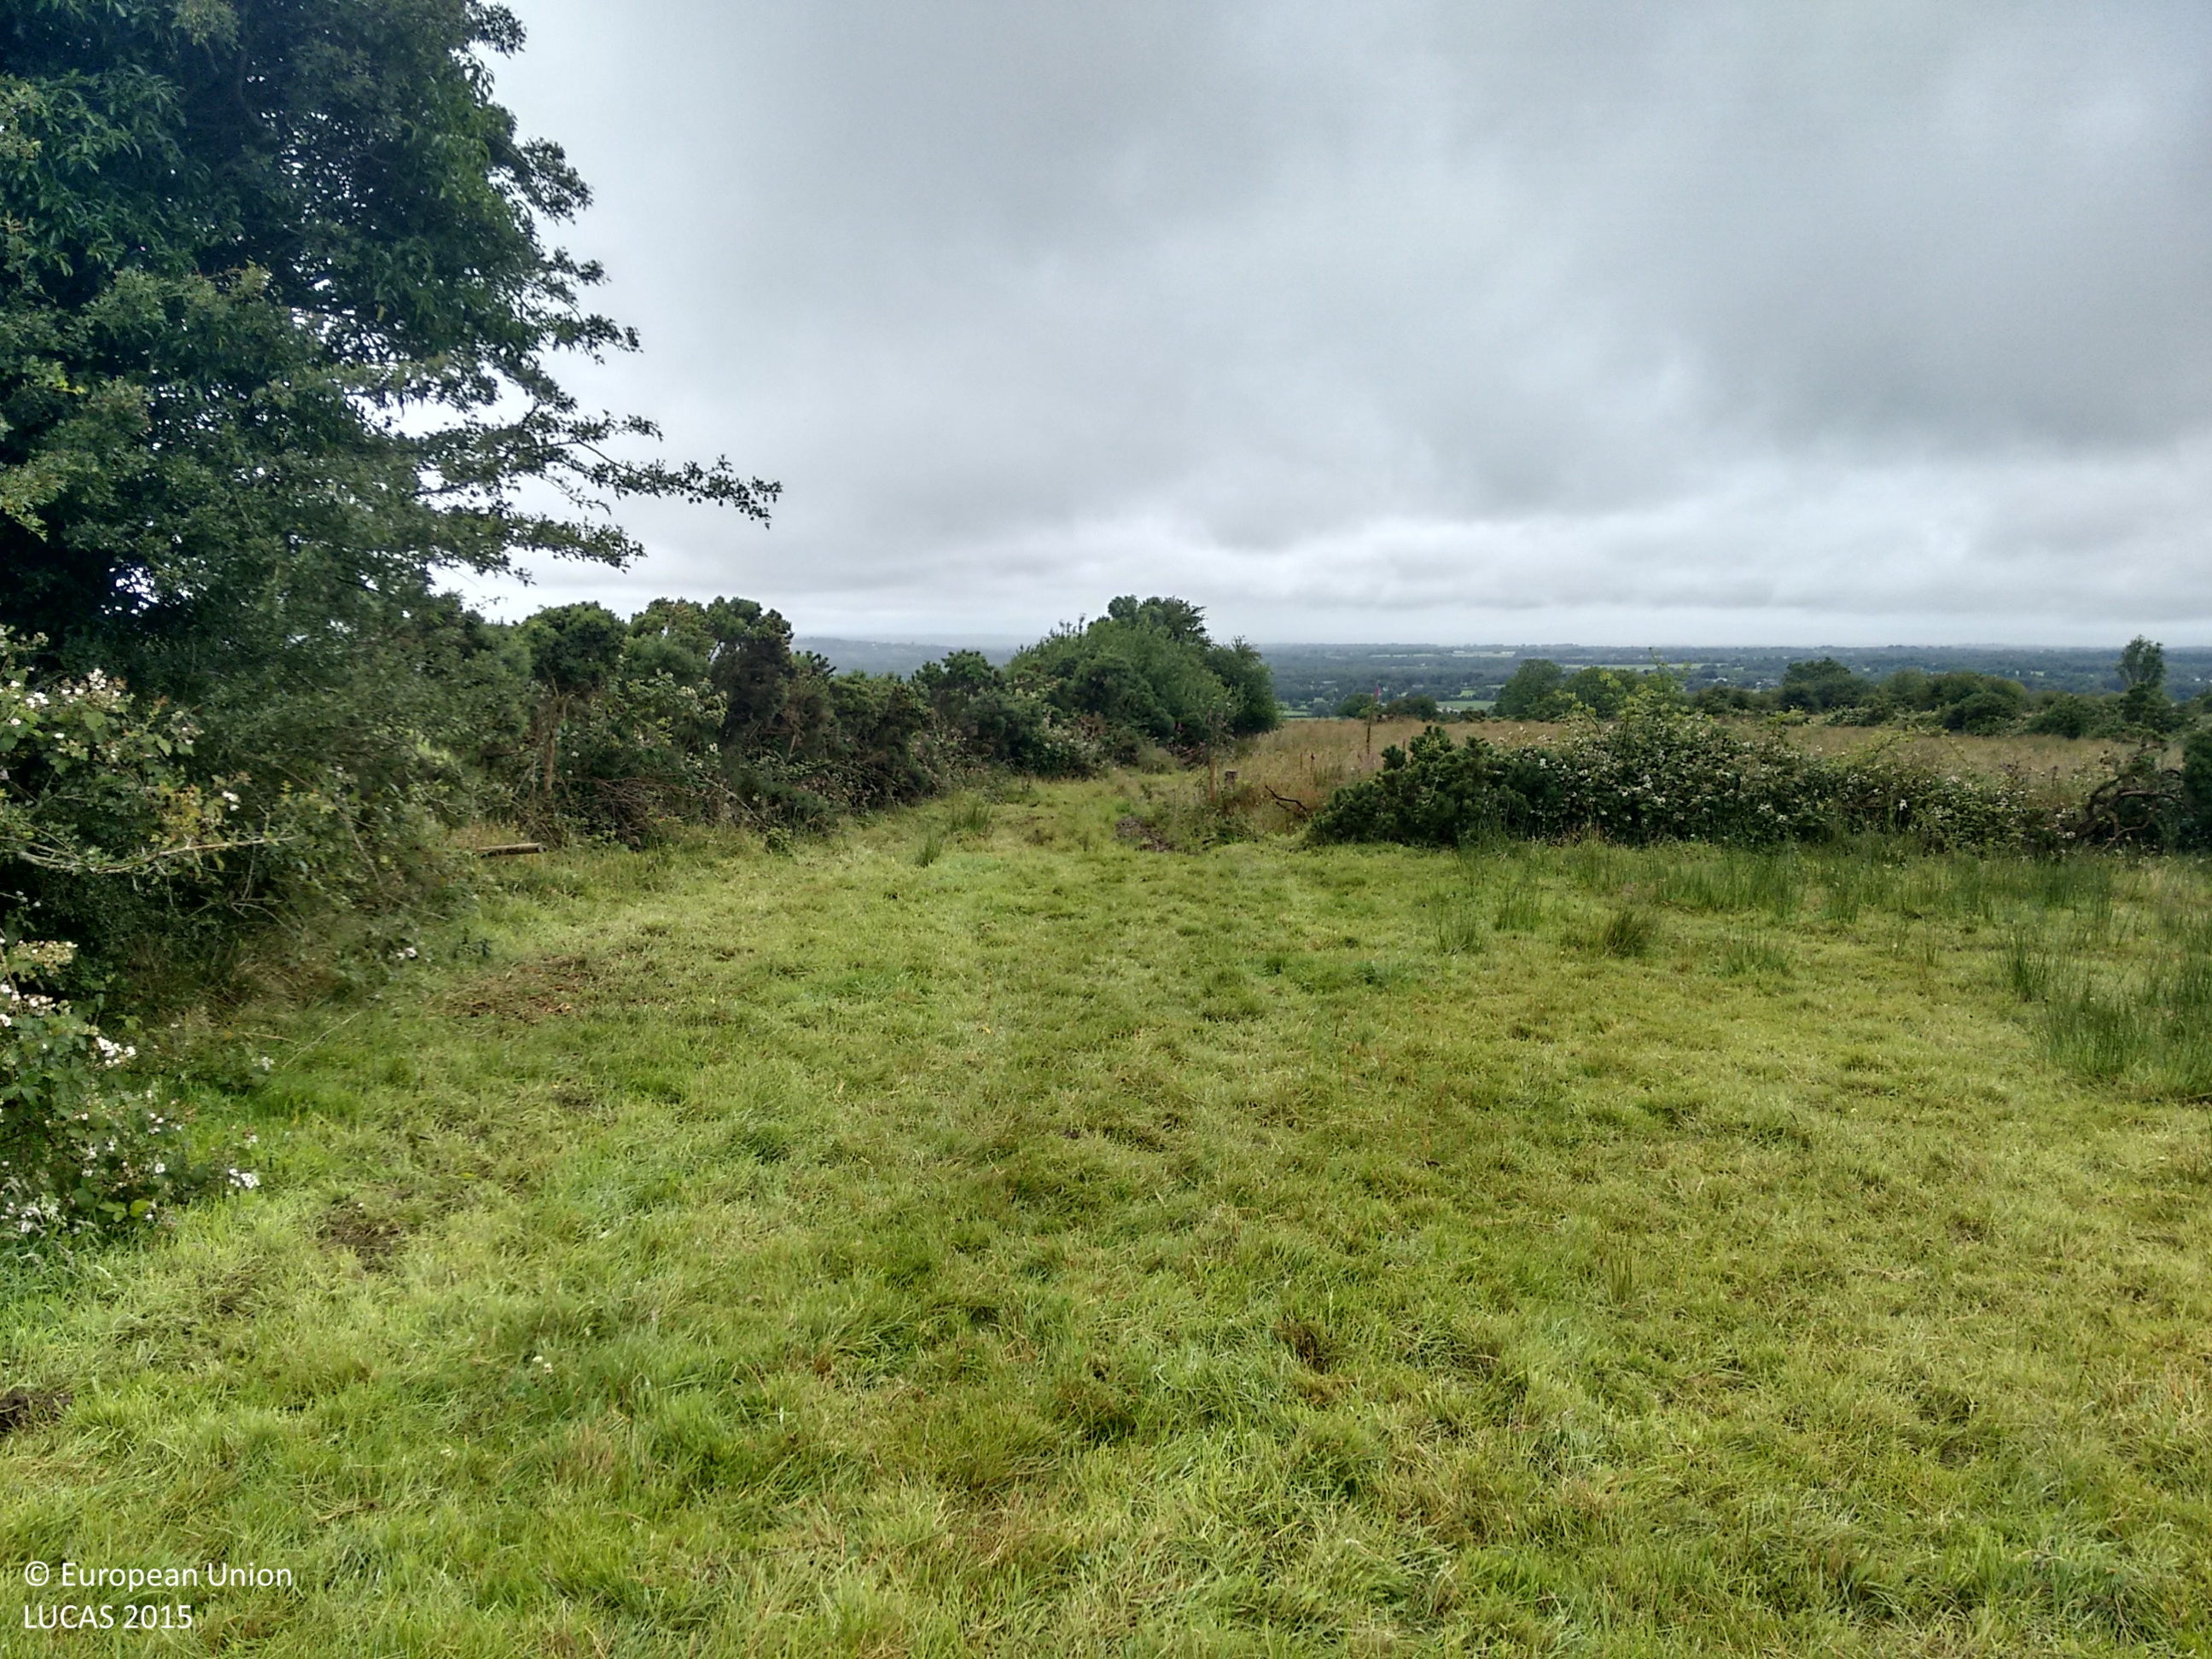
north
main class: Grassland
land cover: Grassland without tree/shrub cover
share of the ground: > 75 %
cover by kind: herbaceous plants 100 %
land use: Agriculture (excluding fallow land and kitchen gardens)
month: July
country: IE
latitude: 53.6630
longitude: -7.7358
